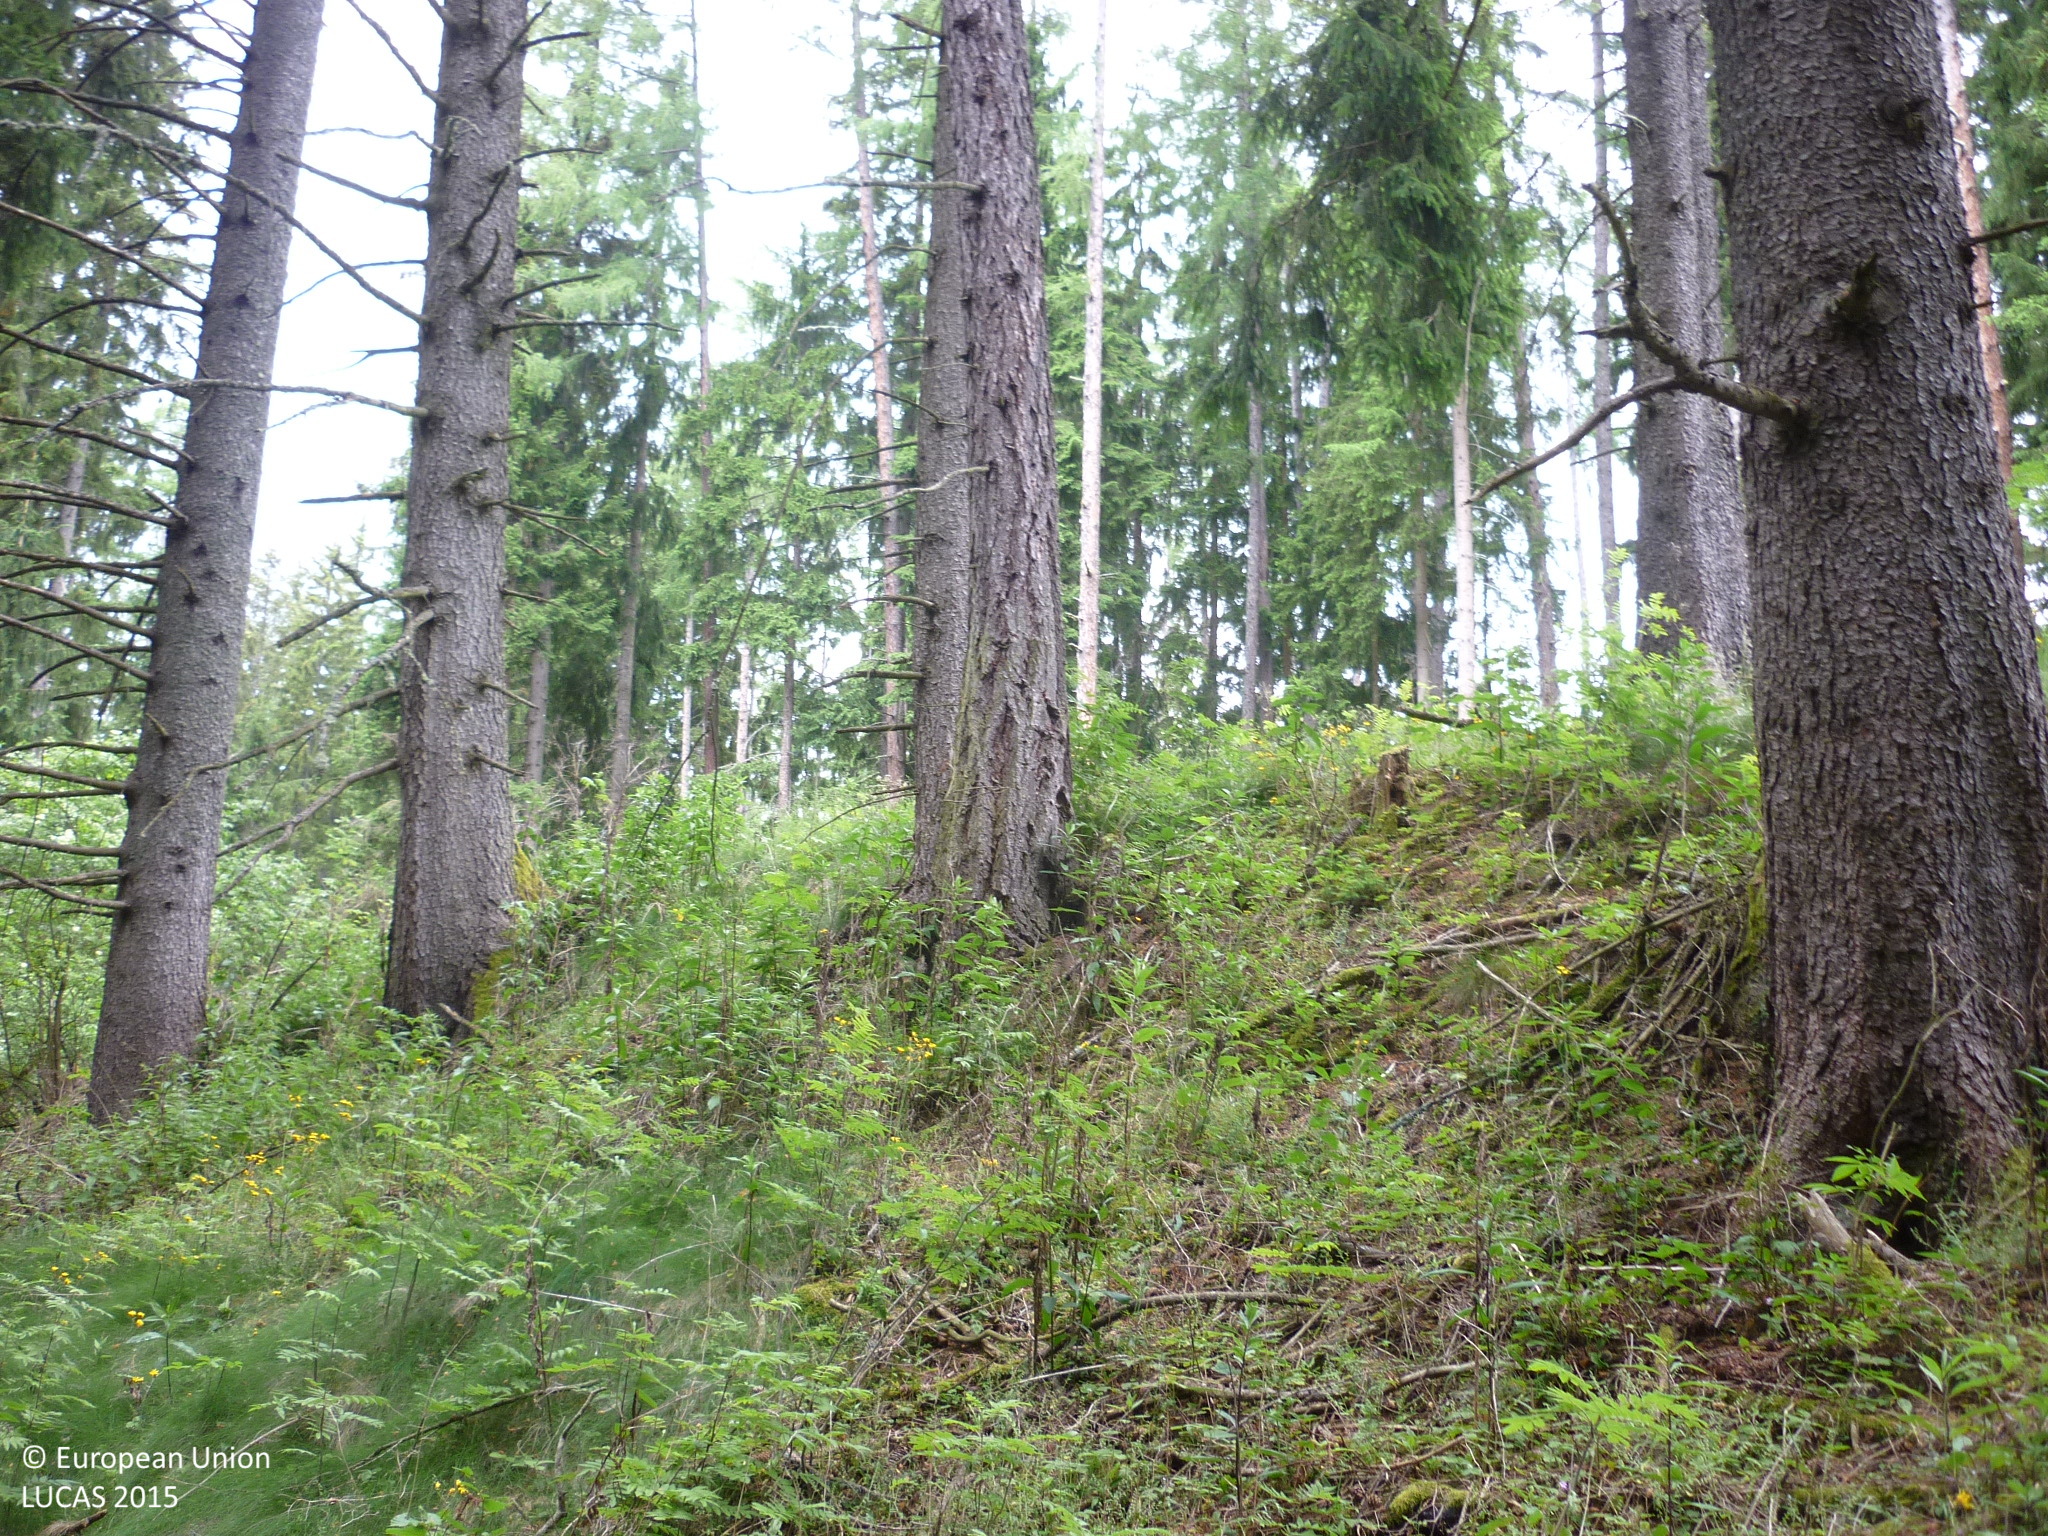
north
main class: Woodland
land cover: Spruce dominated coniferous woodland
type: alpine coniferous forest
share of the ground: 50 - 75 %
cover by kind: coniferous forest trees 60 %, herbaceous plants 35 %, shrubs 5 %
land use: Forestry
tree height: > 5 m
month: June
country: AT
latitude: 47.0697
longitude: 14.4624
